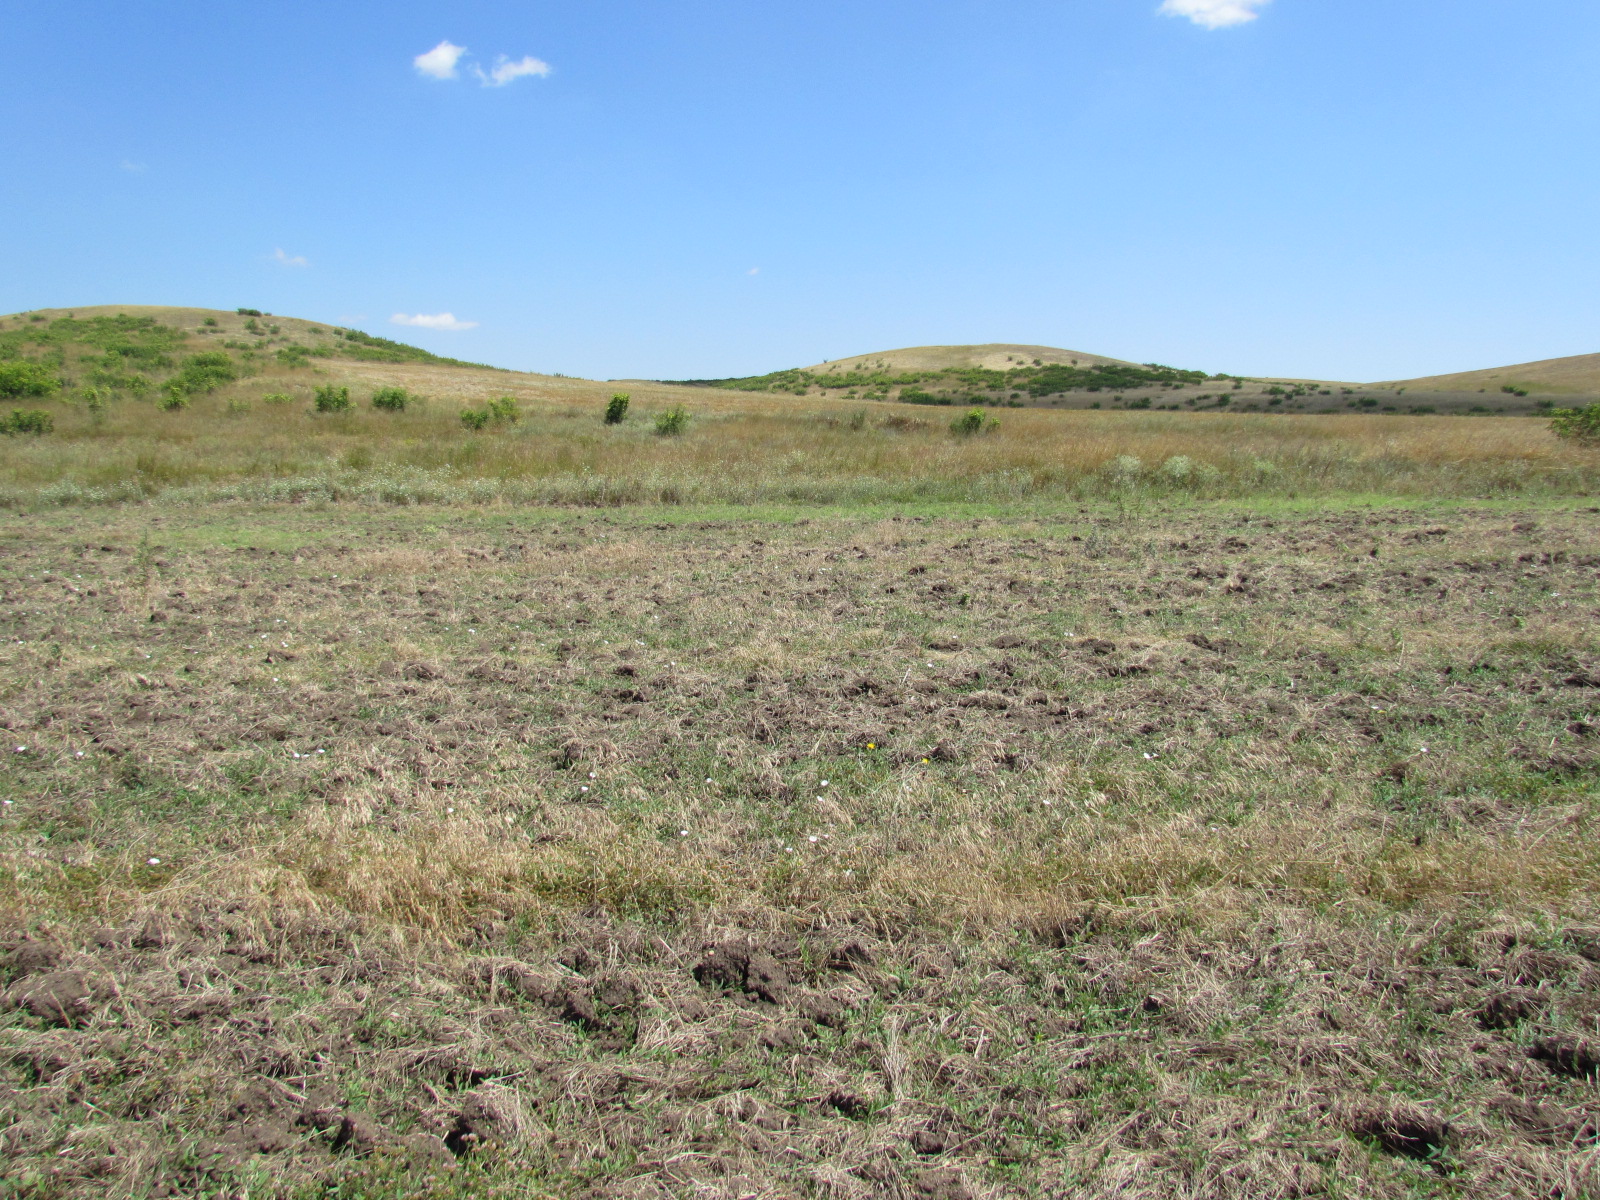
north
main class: Grassland
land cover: Spontaneously vegetated surfaces
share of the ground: 50 - 75 %
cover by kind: herbaceous plants 70 %, unconsolidated bare surface 30 %
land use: Fallow land
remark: Tilled/Sowed
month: July
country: BG
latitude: 42.6022
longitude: 27.4372
